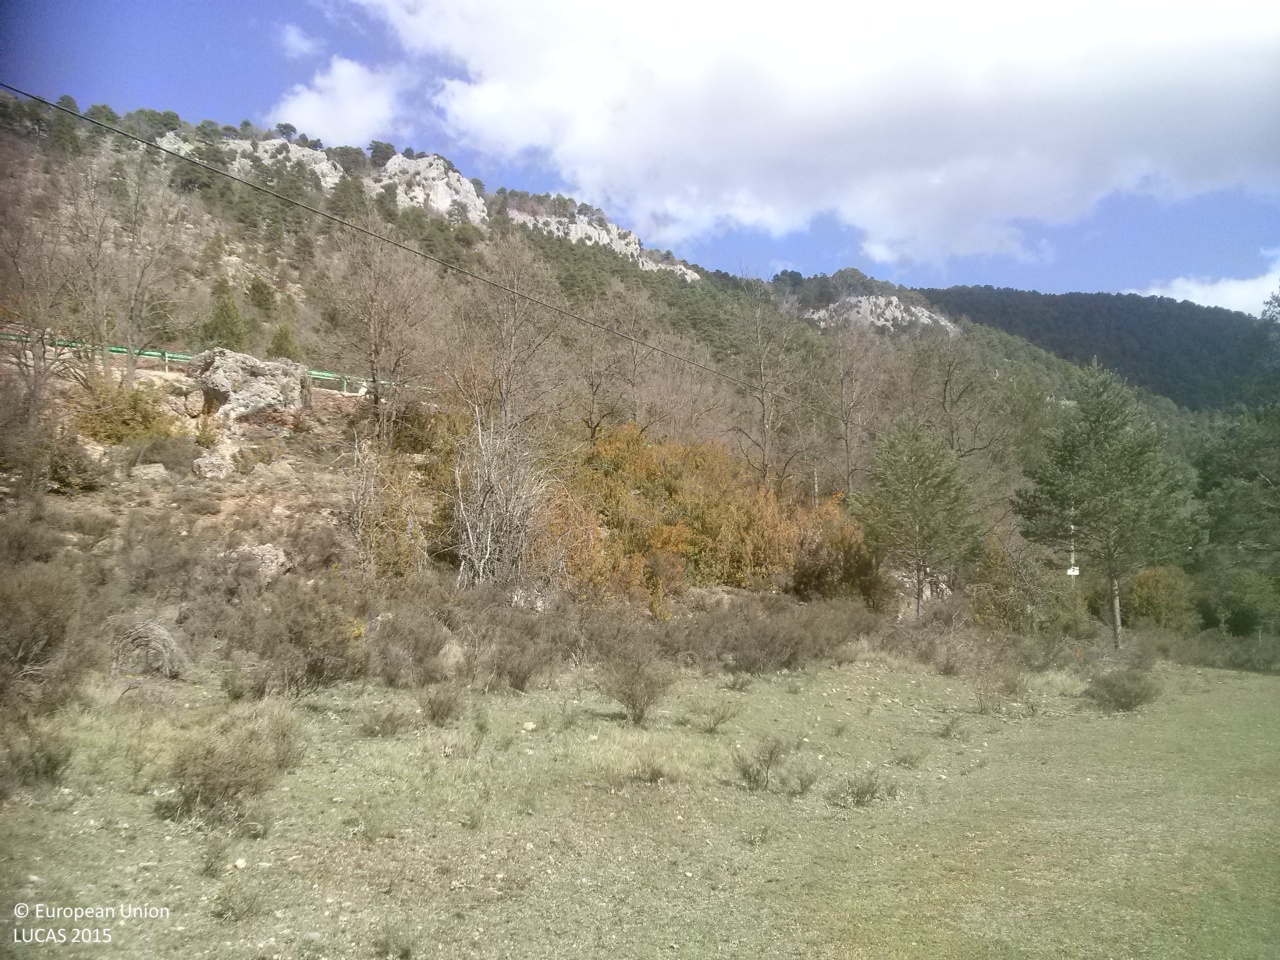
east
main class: Woodland
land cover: Pine dominated coniferous woodland
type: coniferous forest of the mediterranean region
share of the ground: > 75 %
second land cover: Grassland without tree/shrub cover
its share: 10 - 25 %
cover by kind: coniferous forest trees 80 %, shrubs 10 %, herbaceous plants 10 %
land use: Forestry
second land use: Agriculture (excluding fallow land and kitchen gardens)
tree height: > 5 m
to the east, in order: Pine dominated coniferous woodland; Grassland without tree/shrub cover; Pine dominated coniferous woodland; Electric lines; Grassland with sparse tree/shrub cover
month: April
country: ES
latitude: 40.2844
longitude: -1.7892
